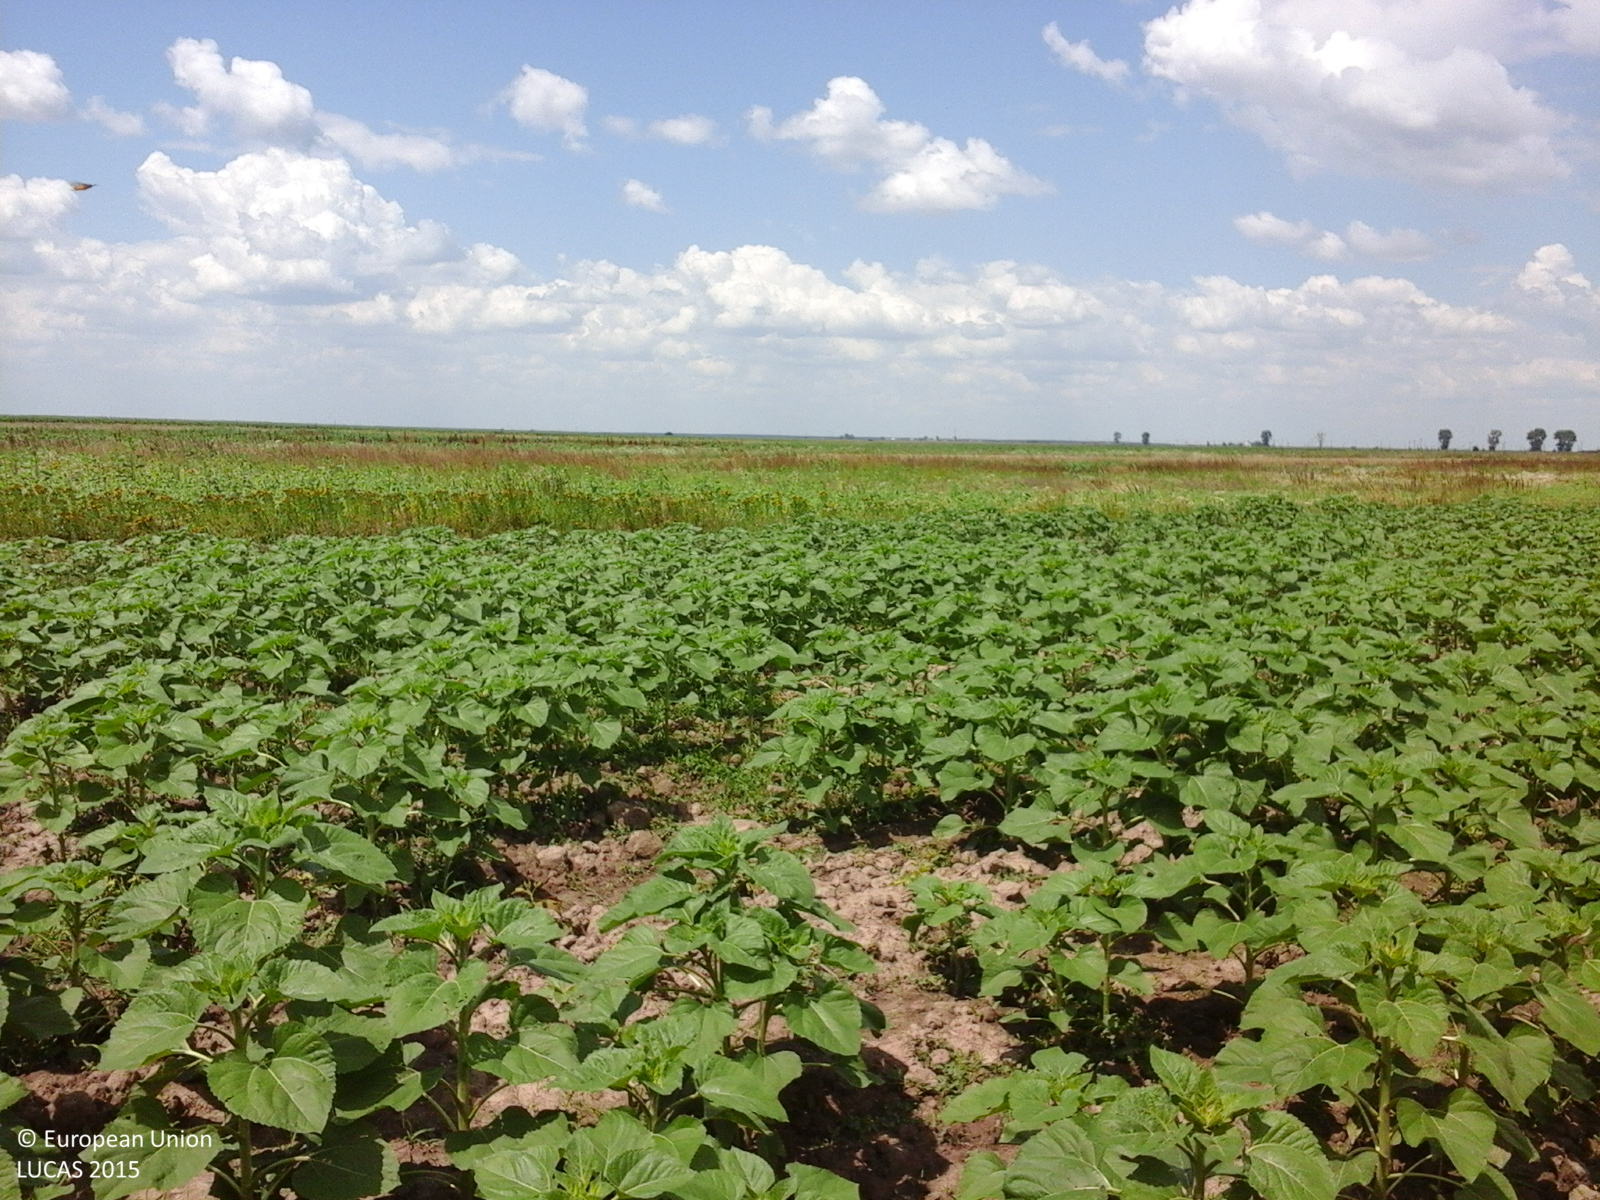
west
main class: Cropland
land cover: Sunflower
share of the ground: 50 - 75 %
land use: Agriculture (excluding fallow land and kitchen gardens)
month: July
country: RO
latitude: 44.3914
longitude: 25.5967
